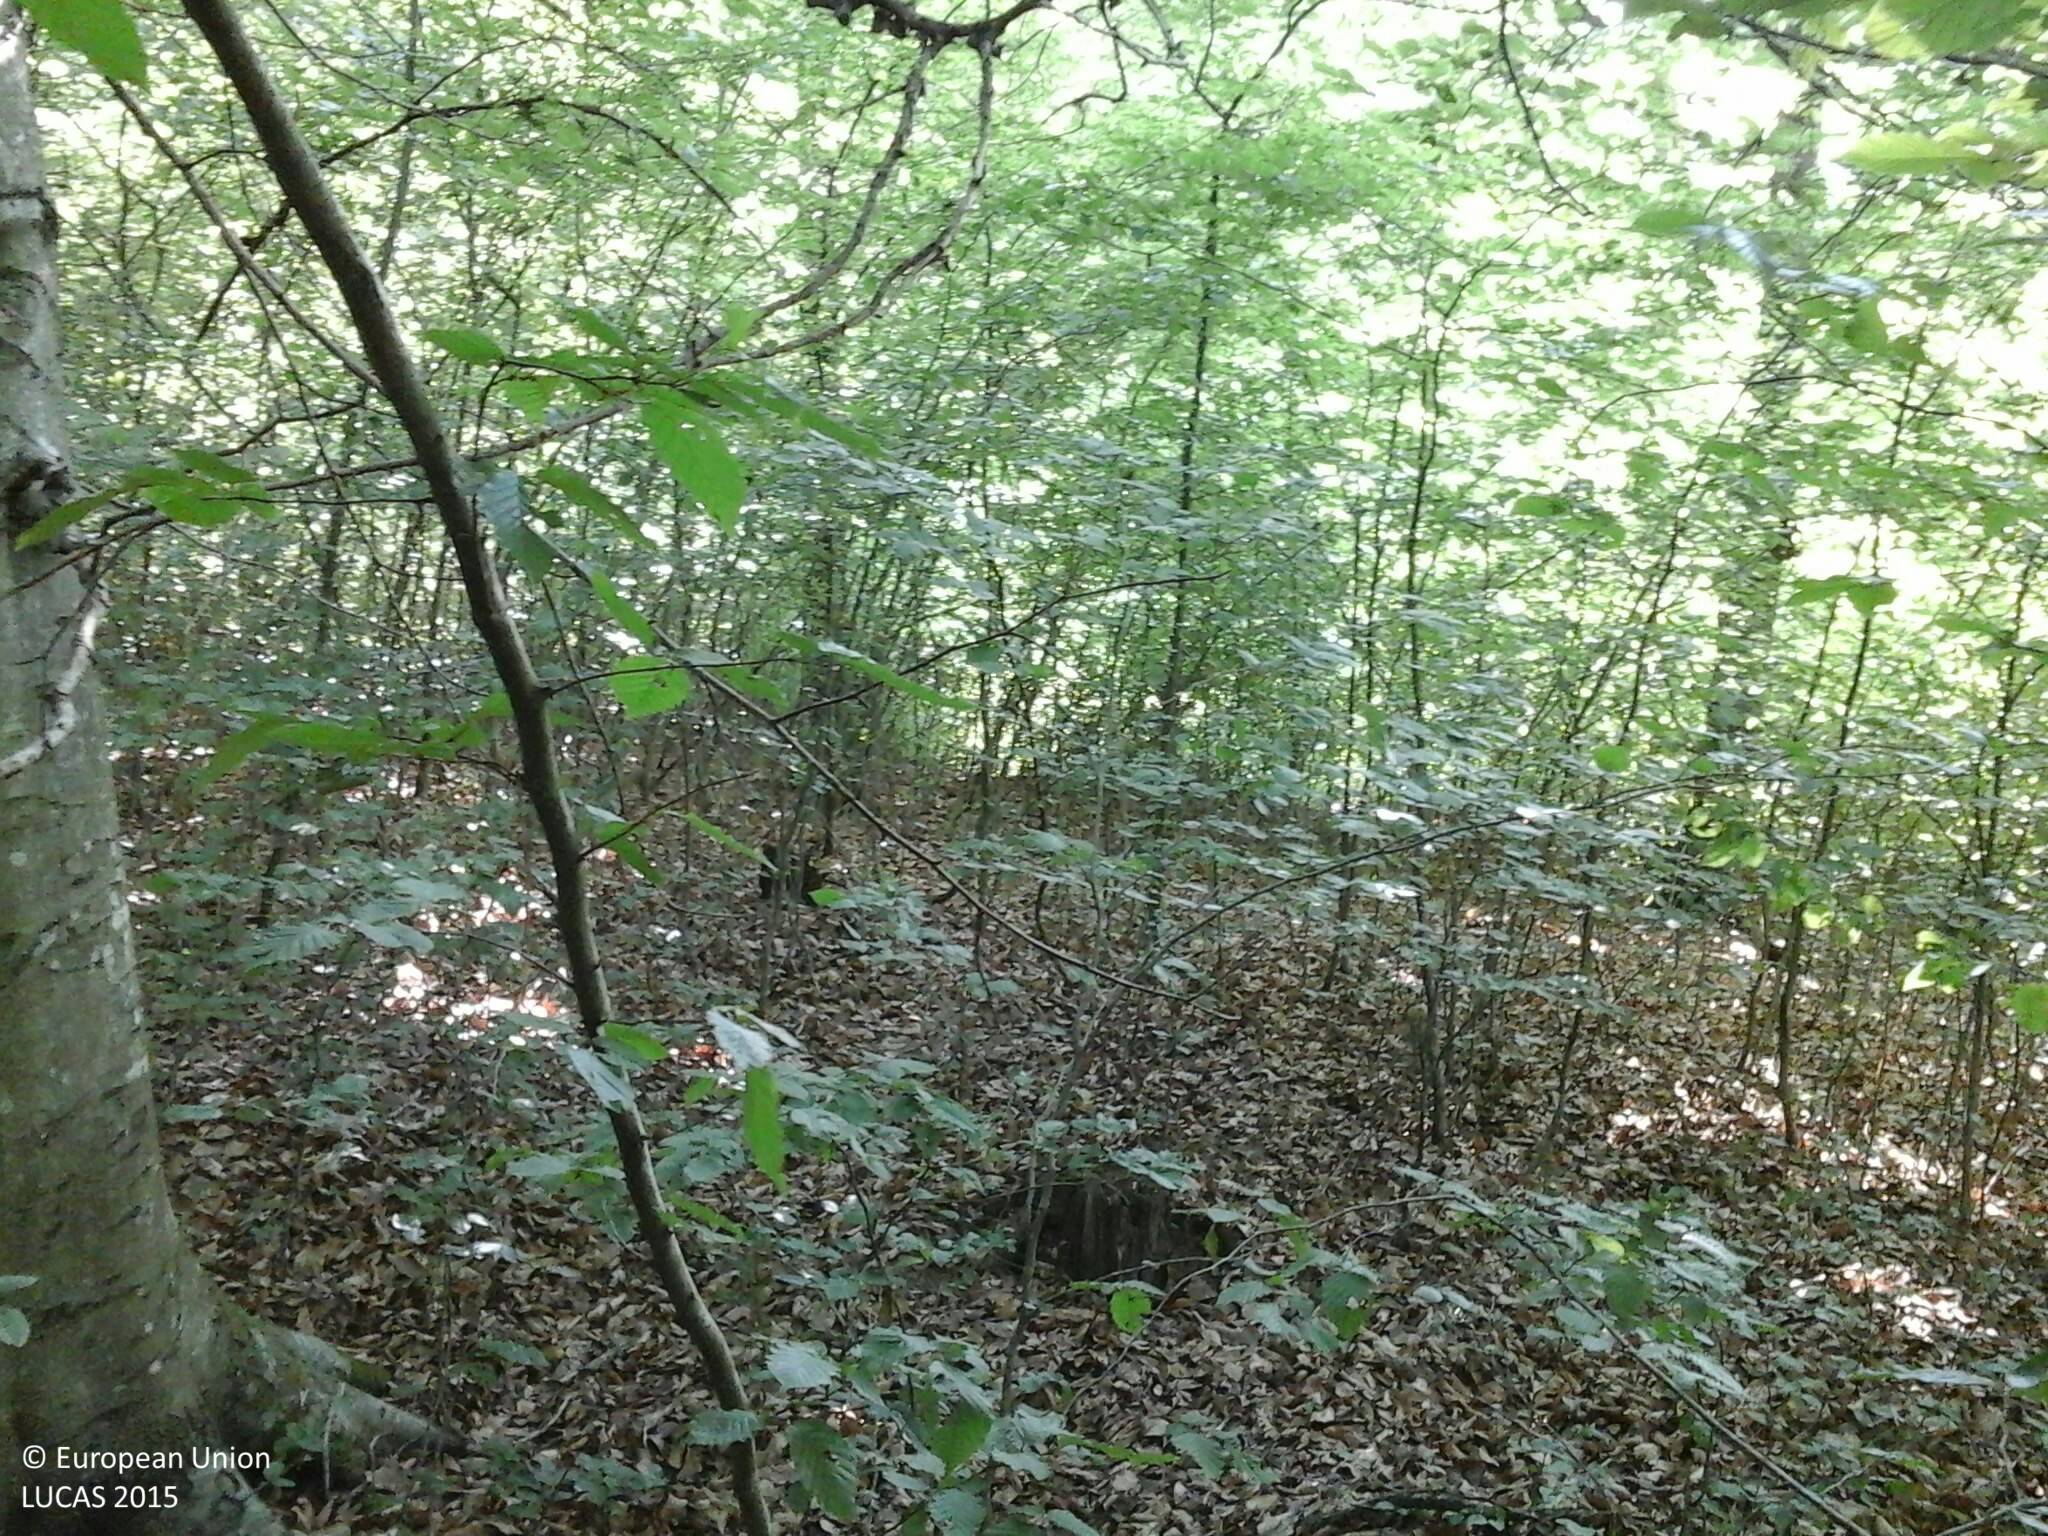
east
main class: Woodland
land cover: Broadleaved woodland
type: beech forest
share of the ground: > 75 %
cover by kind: broadleaved forest trees 95 %, shrubs 5 %
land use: Forestry
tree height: > 5 m
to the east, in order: Broadleaved woodland; Grassland without tree/shrub cover; Broadleaved woodland
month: July
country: HU
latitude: 46.8603
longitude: 16.1530
